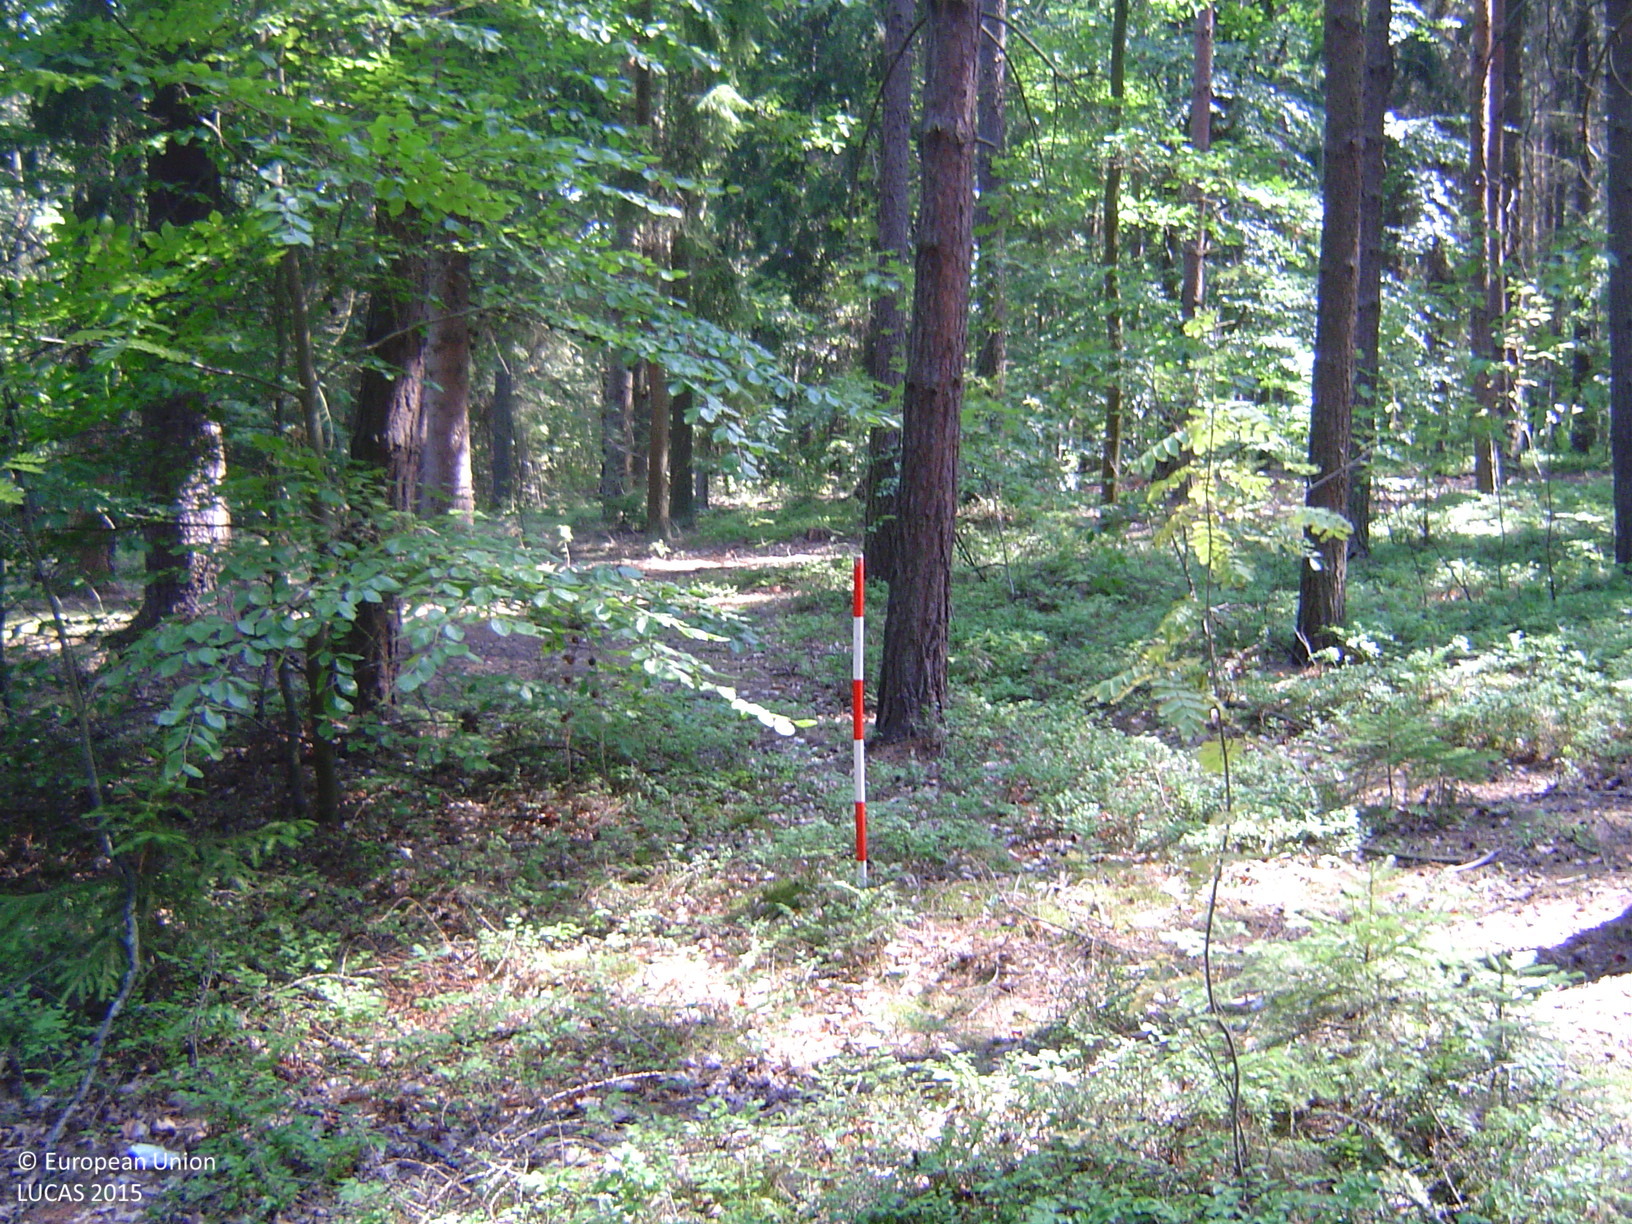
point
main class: Woodland
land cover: Pine dominated mixed woodland
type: hemiboreal forest and nemoral coniferous forest and mixed broadleaved-coniferous forest
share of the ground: > 75 %
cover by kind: coniferous forest trees 70 %, broadleaved forest trees 25 %, herbaceous plants 5 %
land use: Forestry
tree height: > 5 m
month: August
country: CZ
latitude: 50.1732
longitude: 13.8512
